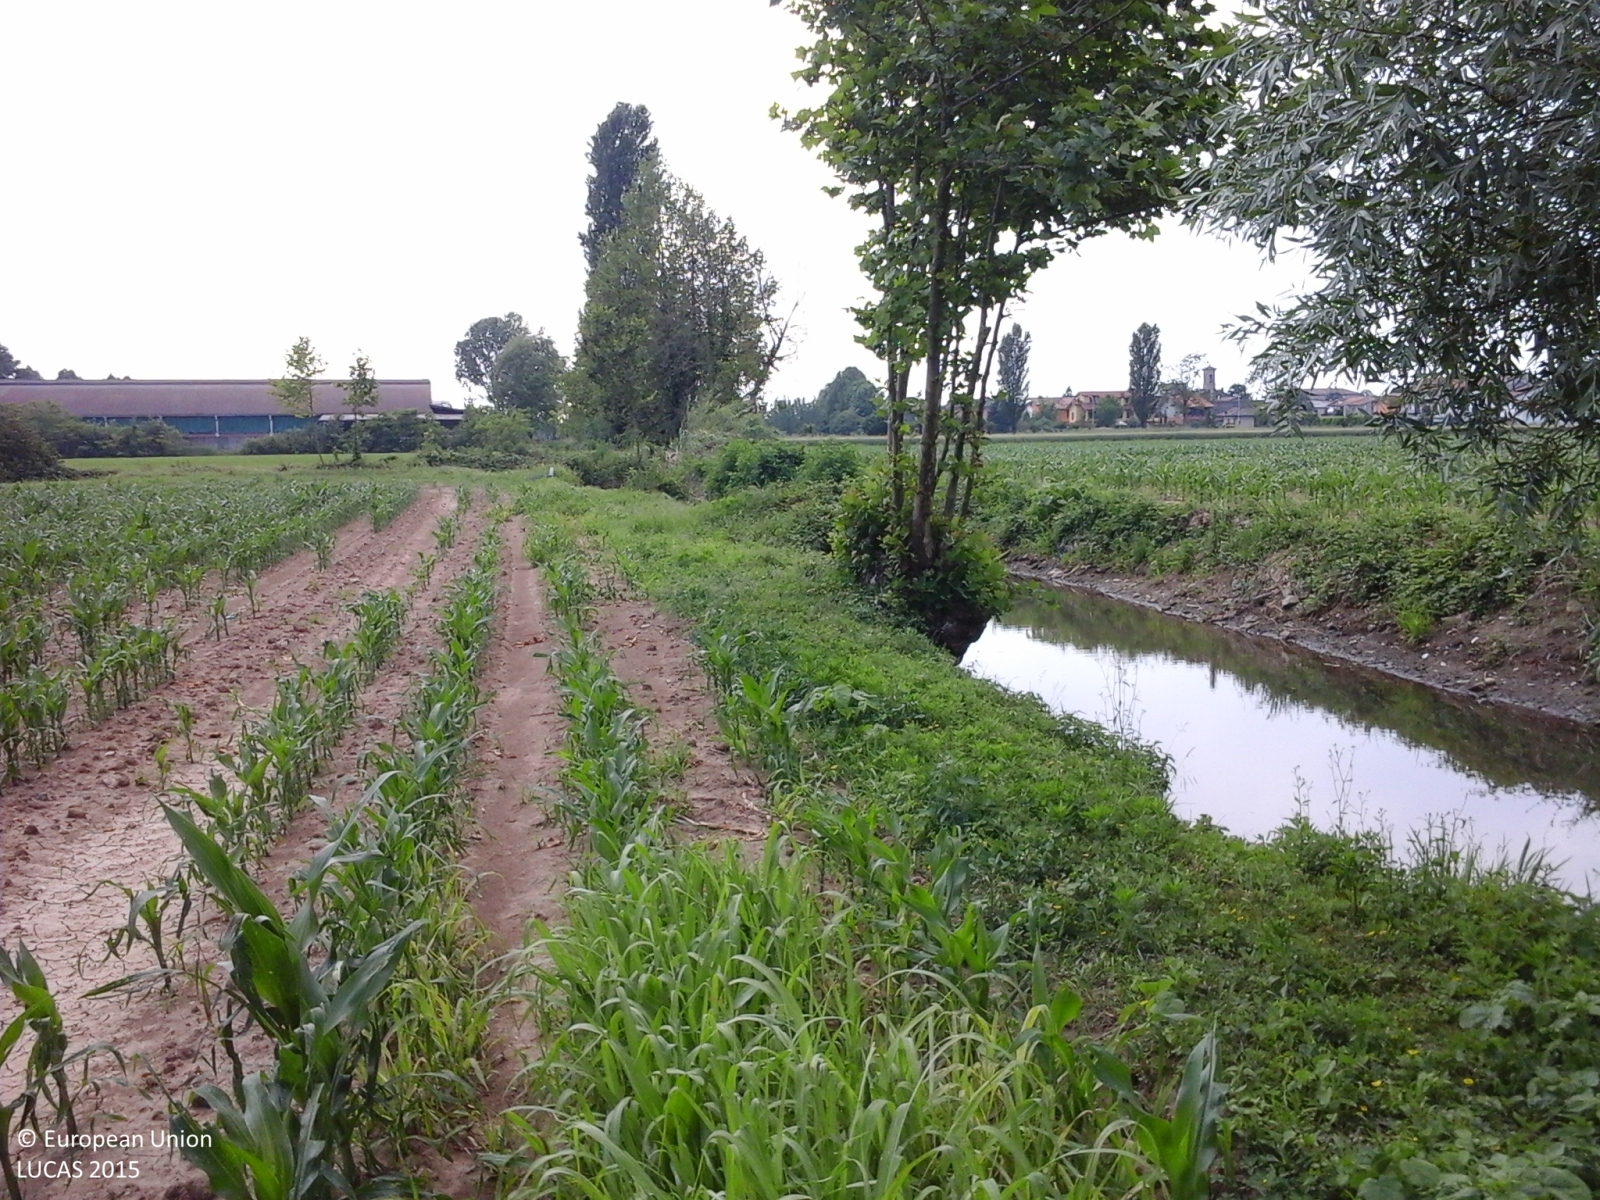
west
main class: Cropland
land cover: Maize
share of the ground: 25 - 50 %
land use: Agriculture (excluding fallow land and kitchen gardens)
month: May
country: IT
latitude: 45.4677
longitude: 9.6297
